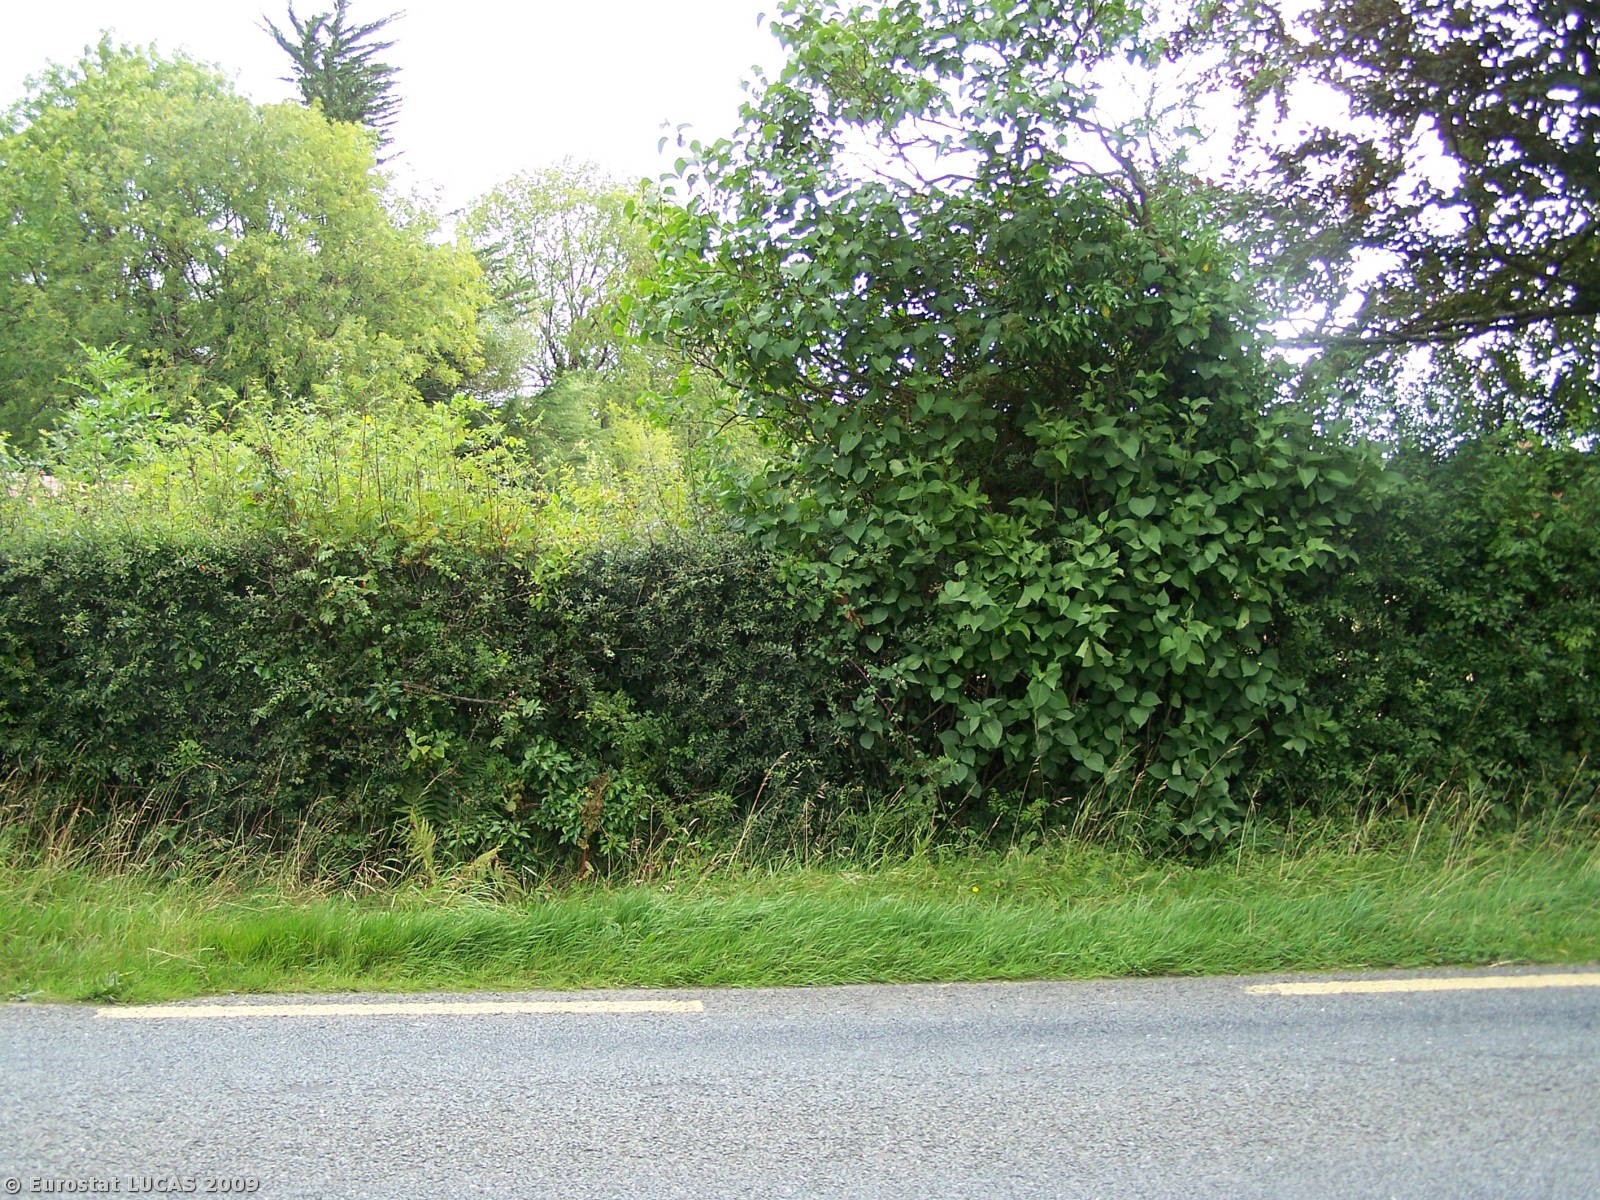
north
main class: Grassland
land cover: Grassland without tree/shrub cover
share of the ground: > 75 %
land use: Agriculture (excluding fallow land and kitchen gardens)
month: August
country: IE
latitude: 52.1432
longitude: -8.8378
